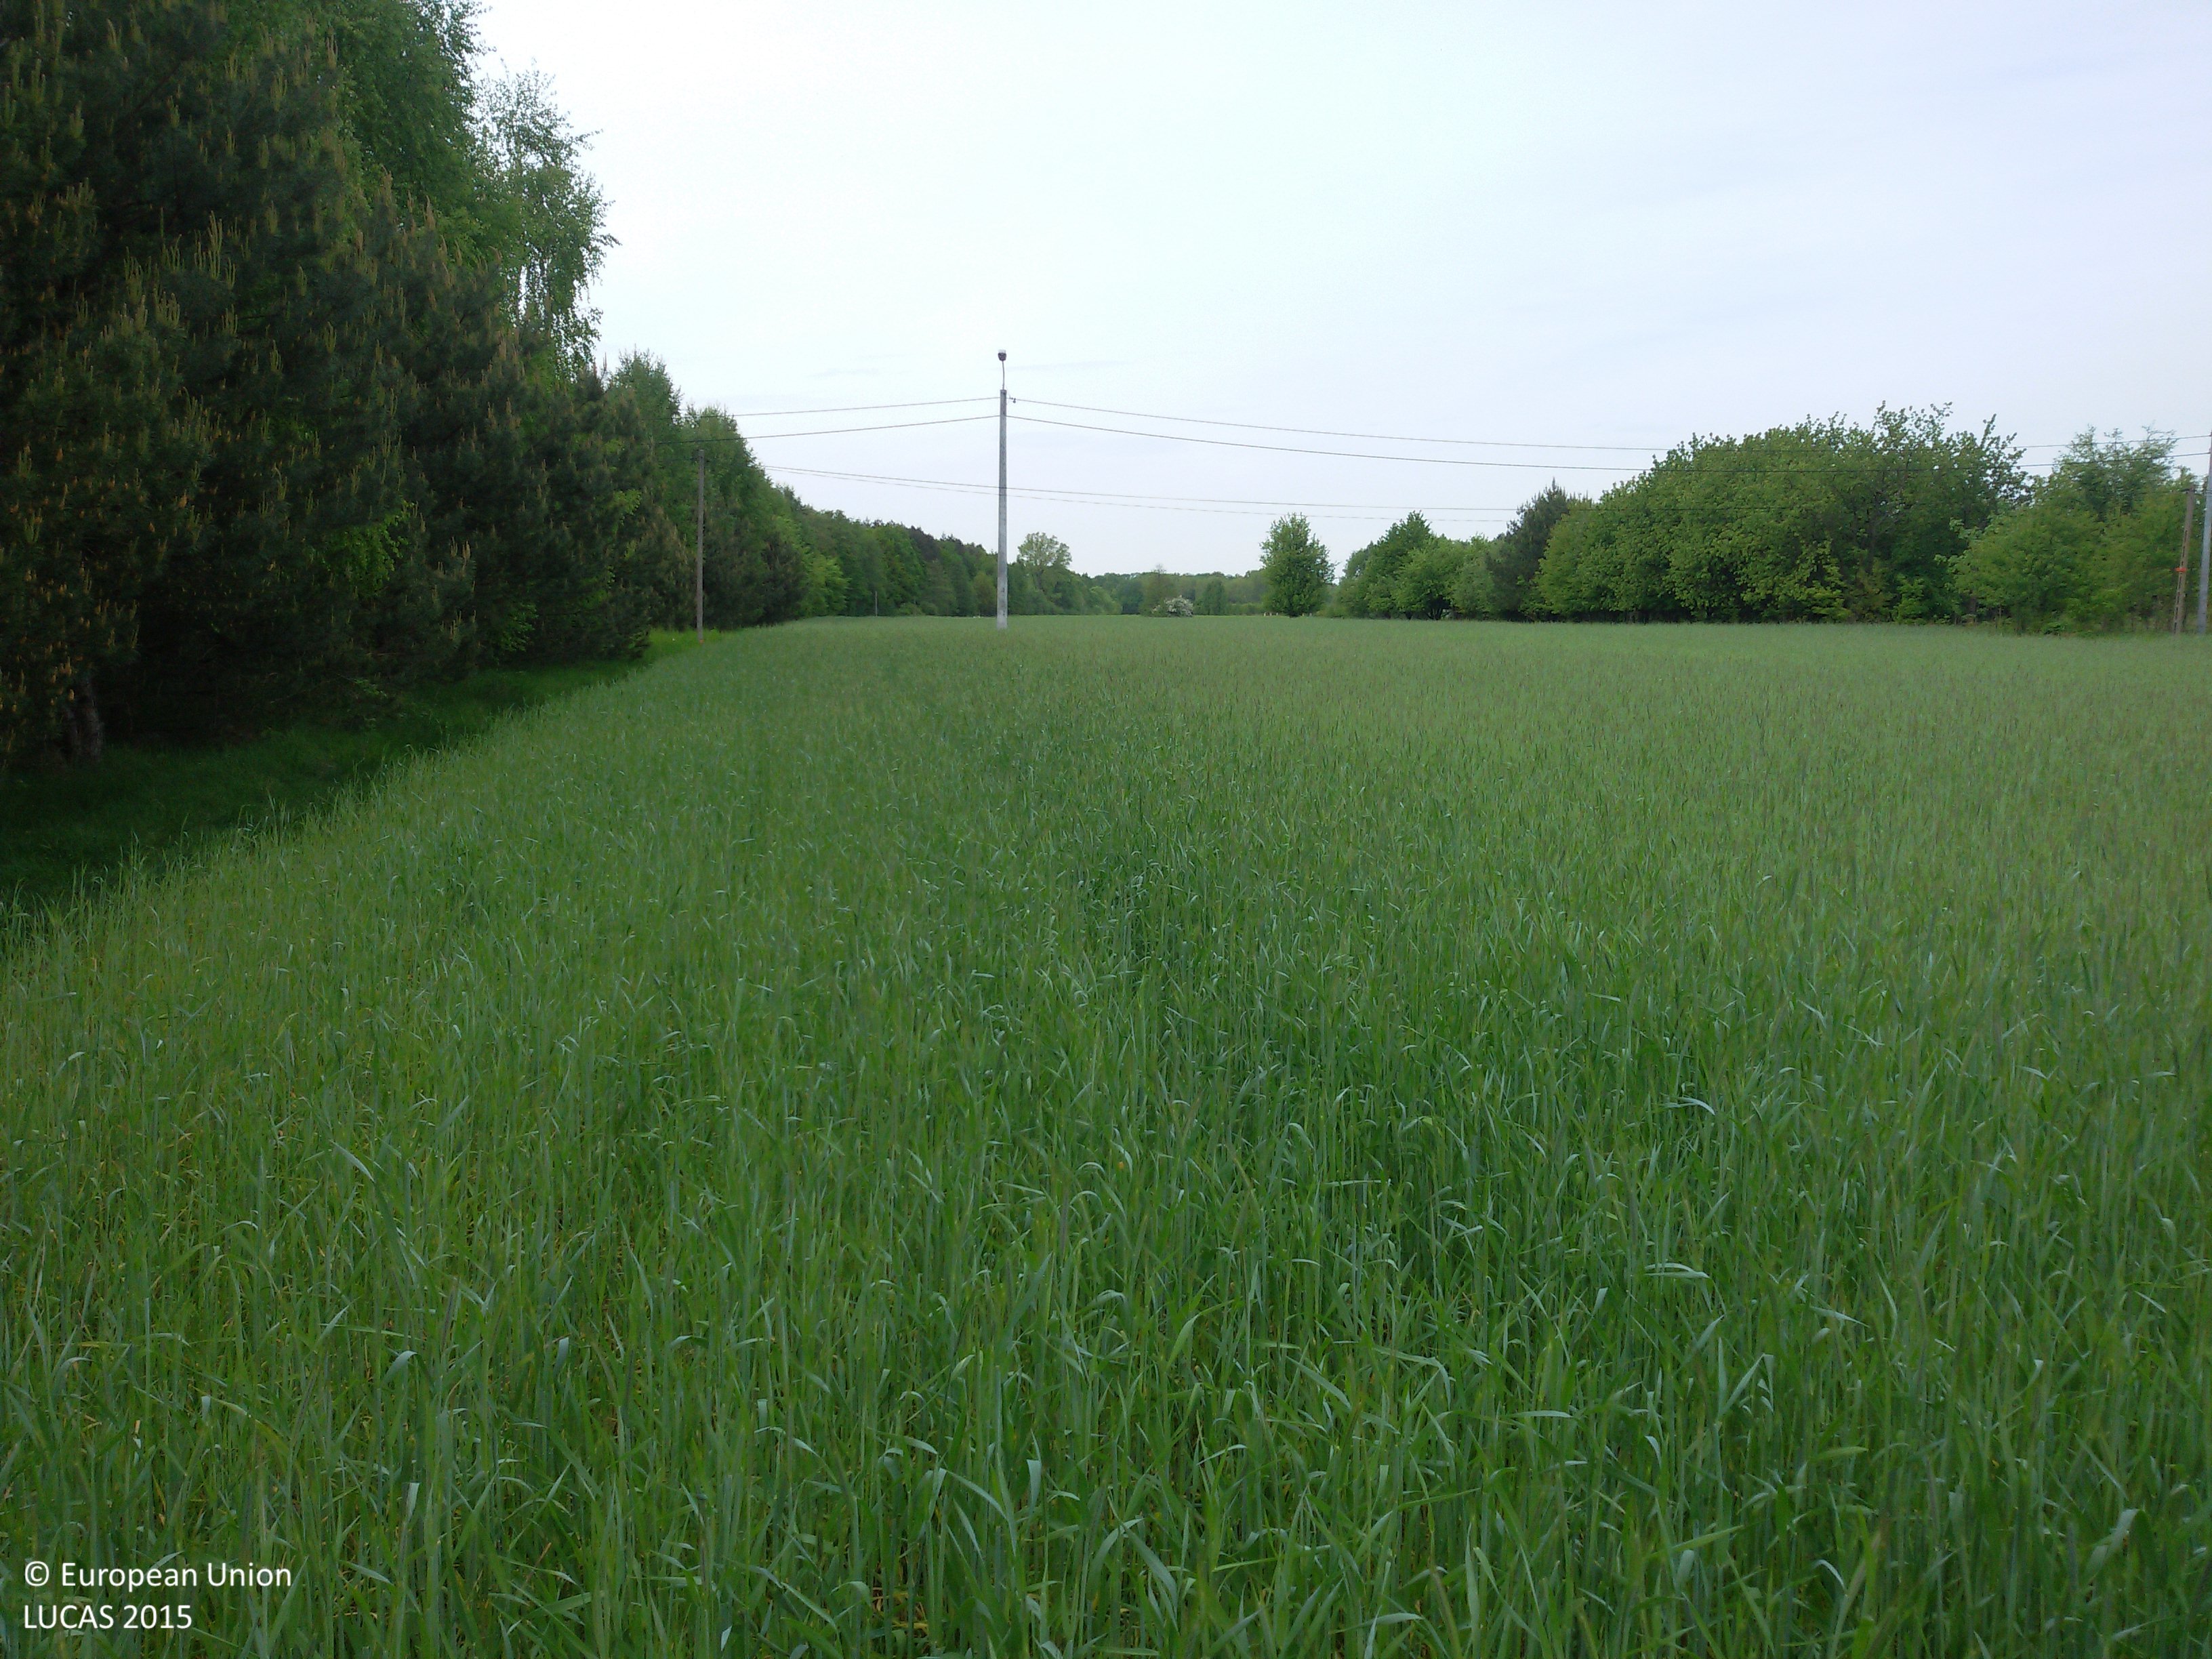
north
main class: Cropland
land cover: Rye
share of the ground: > 75 %
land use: Agriculture (excluding fallow land and kitchen gardens)
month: May
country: PL
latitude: 52.0298
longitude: 20.7839
